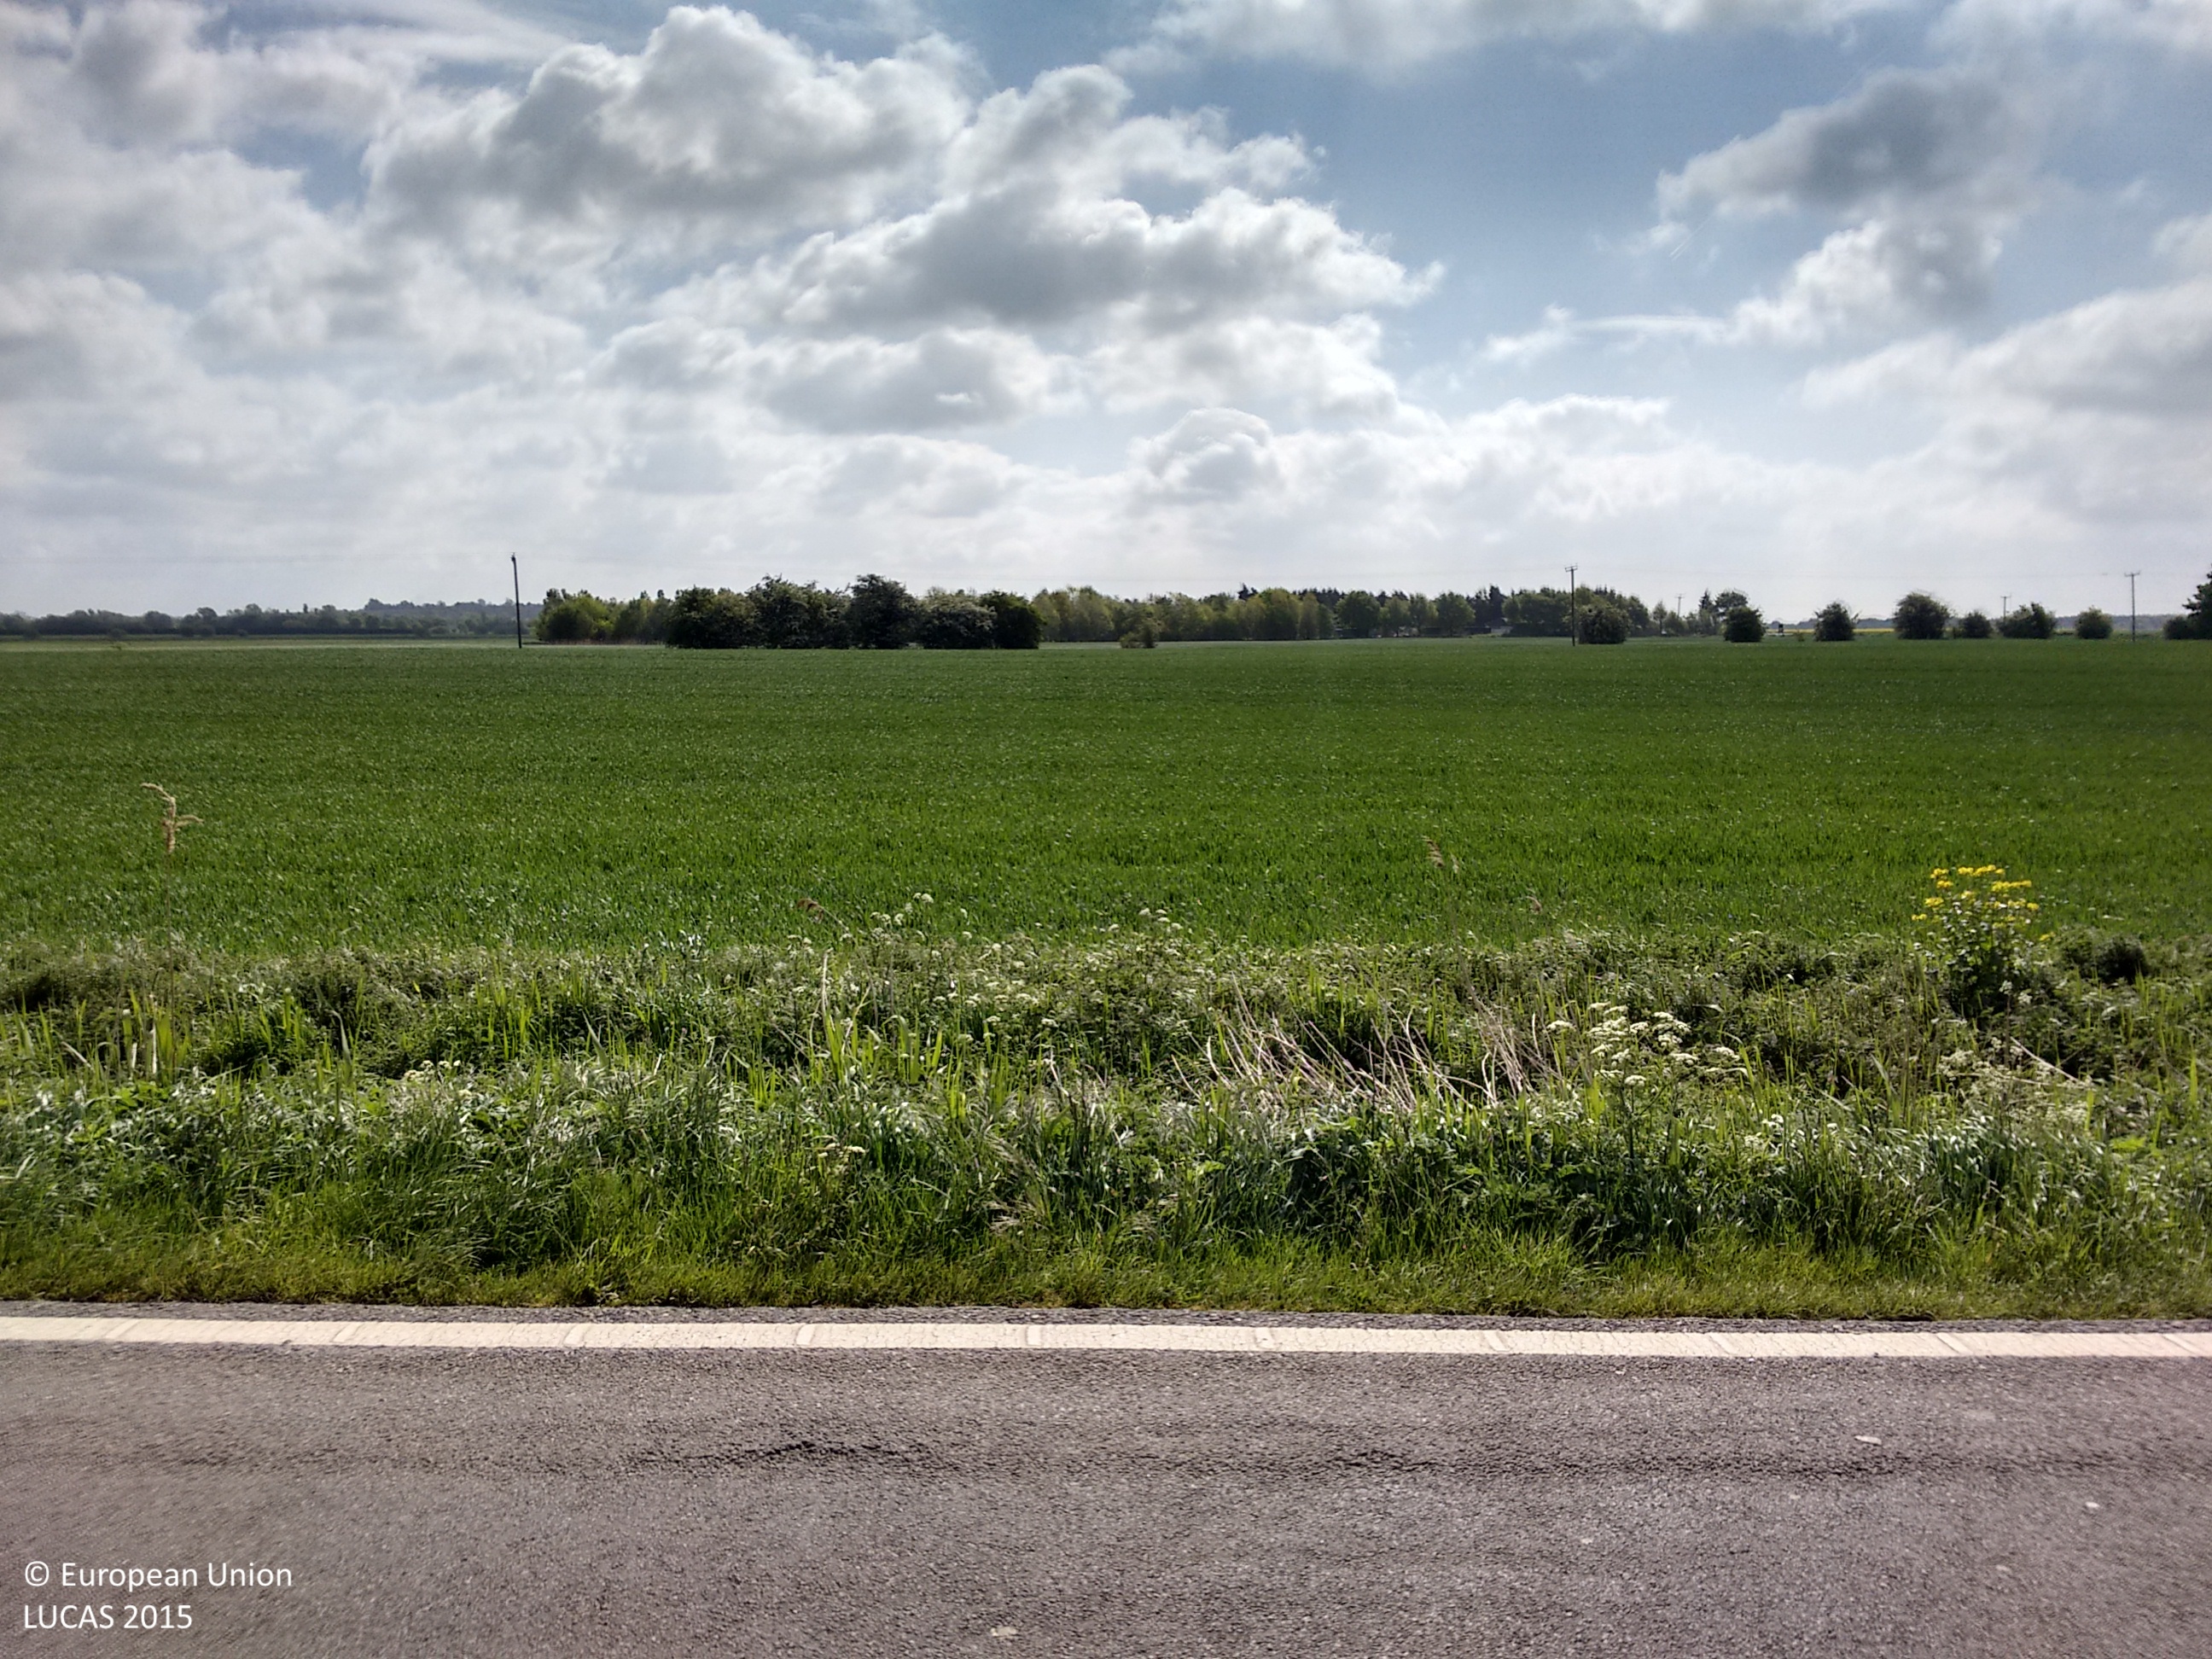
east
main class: Cropland
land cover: Permanent crops (only in case pi)
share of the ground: > 75 %
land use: Agriculture (excluding fallow land and kitchen gardens)
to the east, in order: Permanent crops (only in case pi); Grass margins; Rivers and streams; Grass margins; Paved roads, cycling and walking lanes; Grass margins; Ditches and canals; Grass margins; Permanent crops (only in case pi)
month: May
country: GB
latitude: 53.4883
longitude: -0.9086
